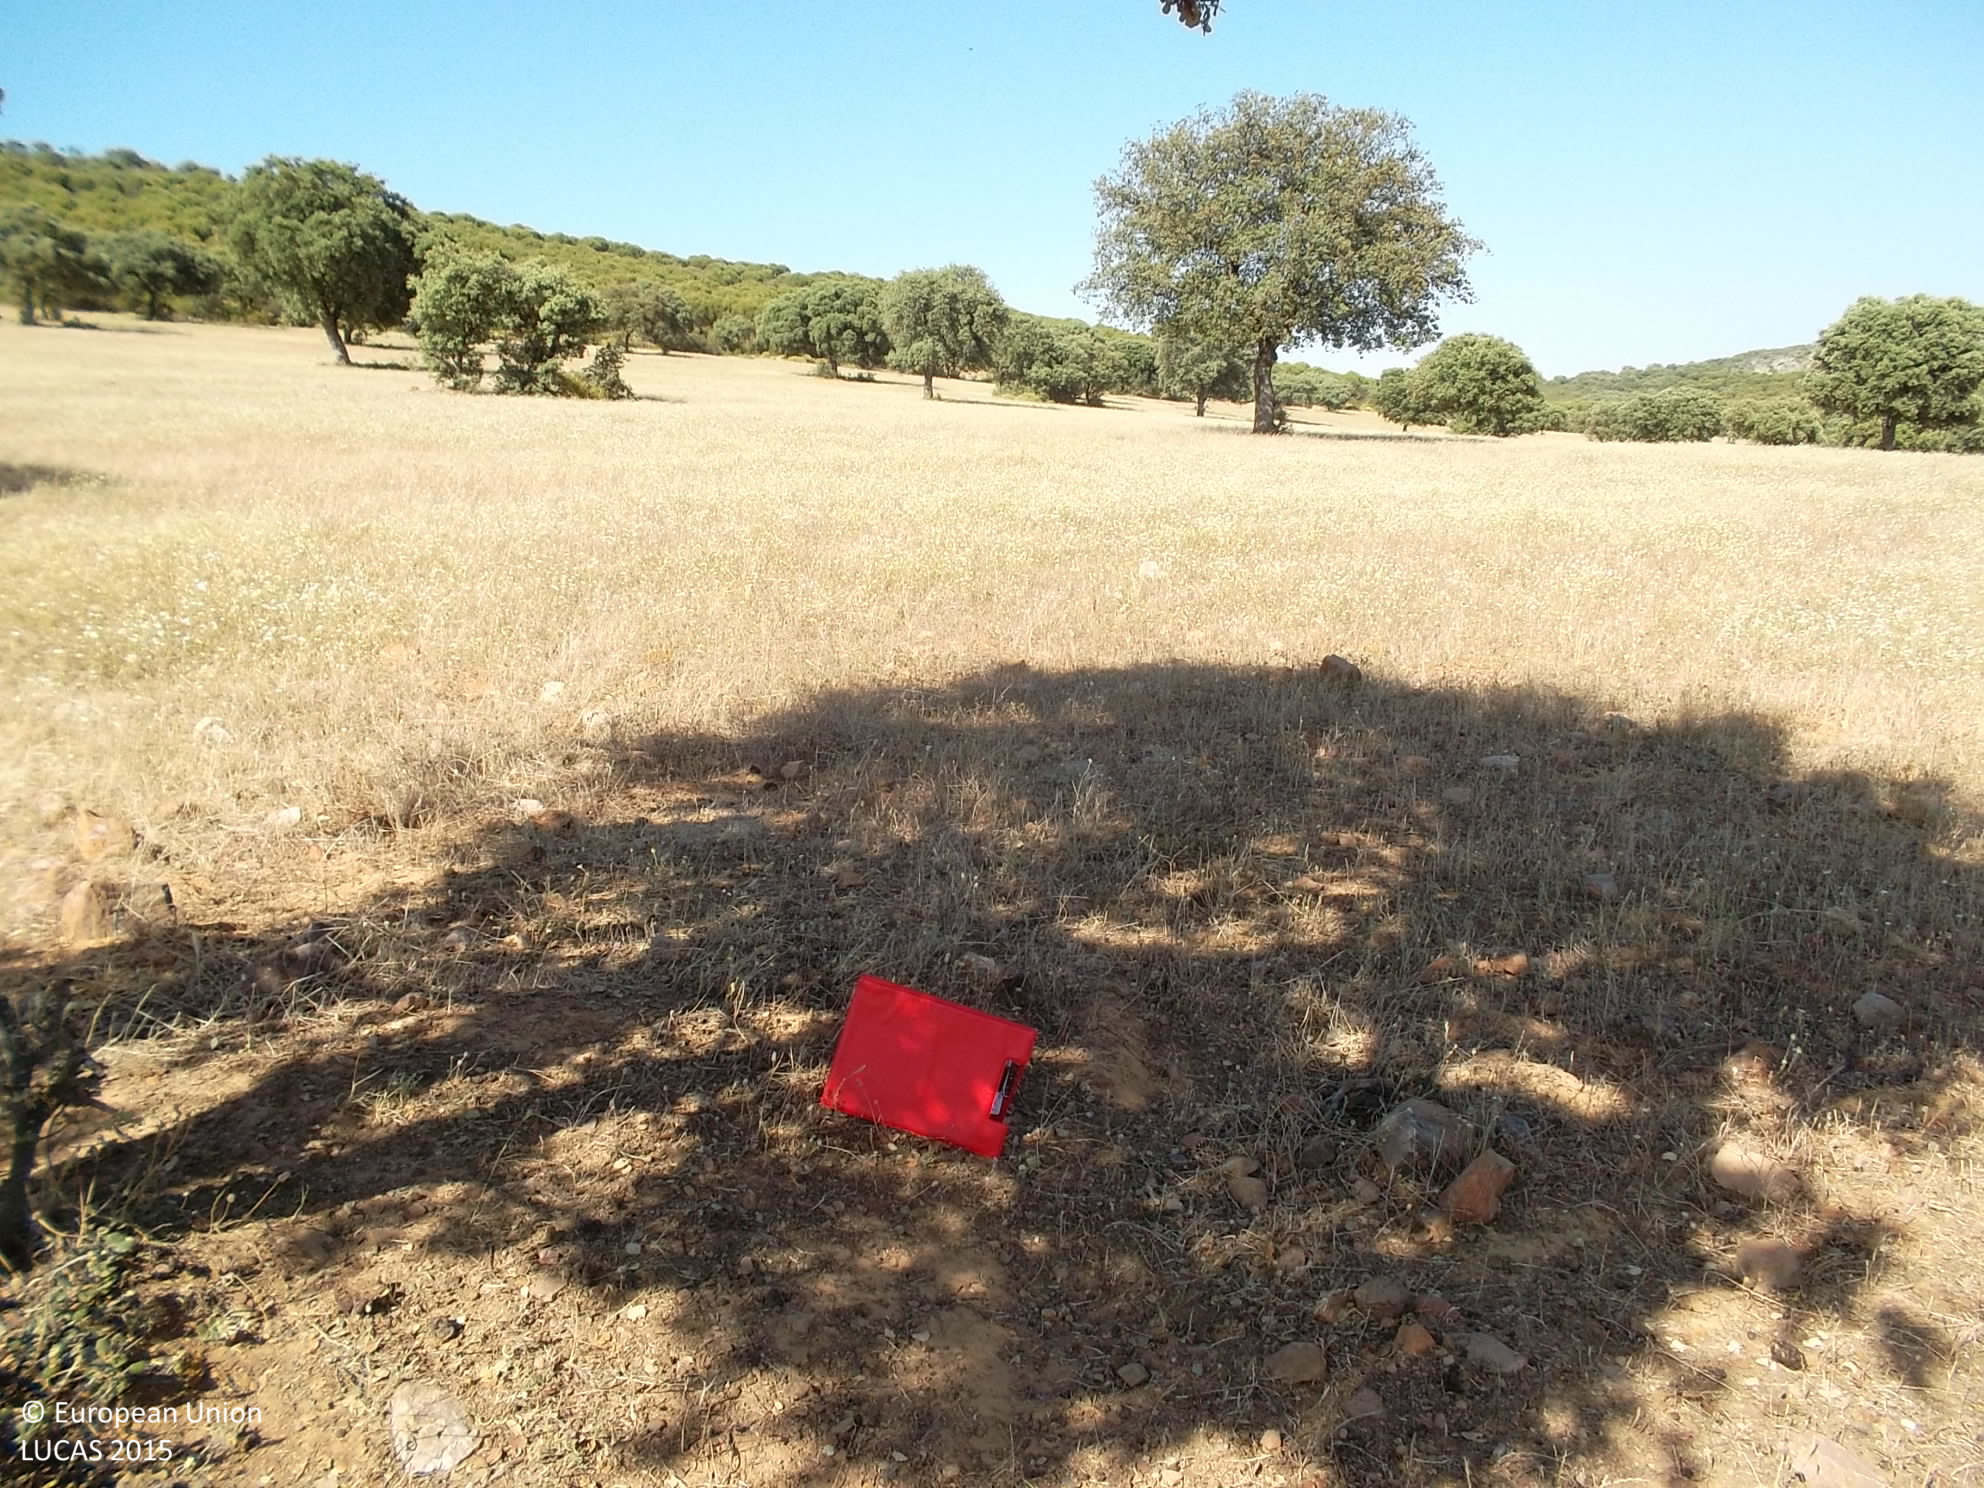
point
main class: Woodland
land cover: Broadleaved woodland
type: broadleaved evergreen forest
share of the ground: 25 - 50 %
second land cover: Spontaneously vegetated surfaces
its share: > 75 %
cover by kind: herbaceous plants 70 %, broadleaved forest trees 30 %
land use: Forestry
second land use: Agriculture (excluding fallow land and kitchen gardens)
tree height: > 5 m
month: May
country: ES
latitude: 38.8210
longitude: -4.8305
